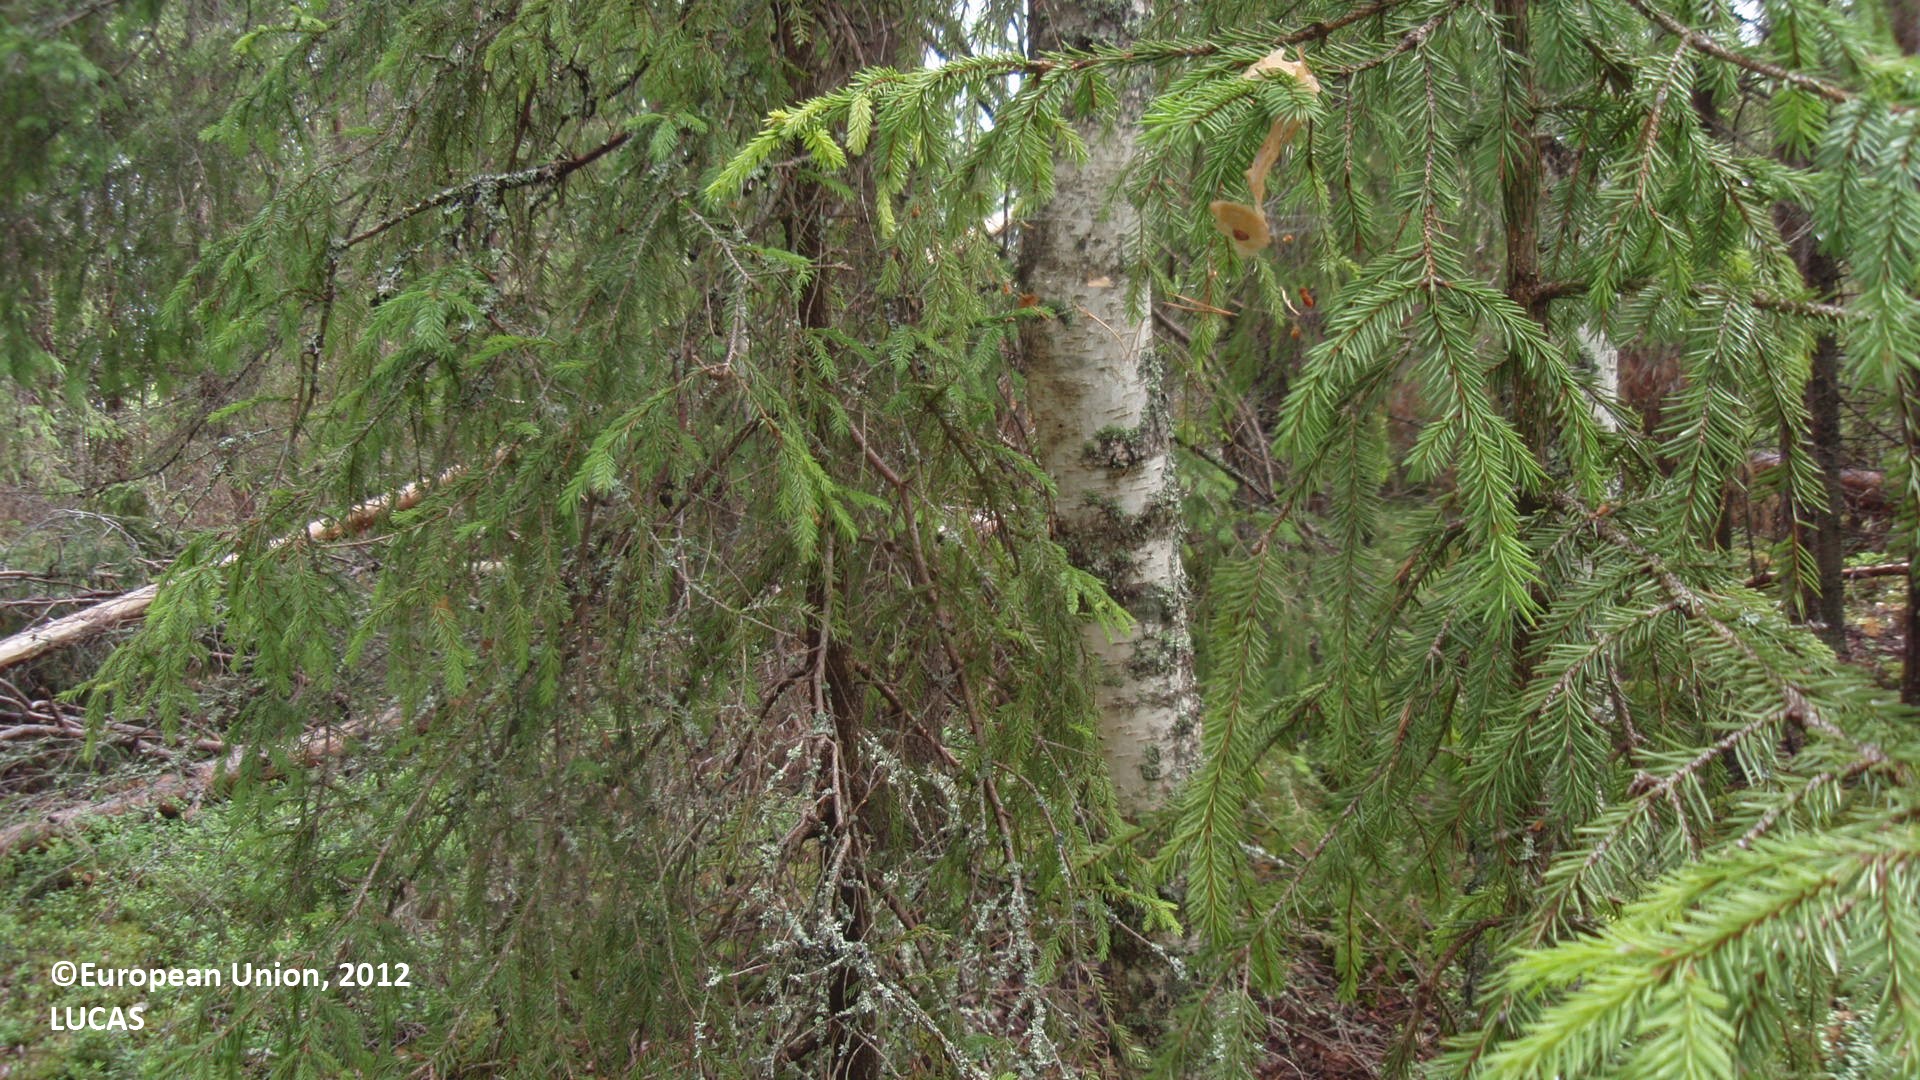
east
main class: Woodland
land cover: Pine dominated mixed woodland
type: boreal forest
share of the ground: 50 - 75 %
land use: Forestry
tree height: > 5 m
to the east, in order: Pine dominated mixed woodland; Spruce dominated mixed woodland; Ditches and canals; Broadleaved woodland; Grassland with sparse tree/shrub cover; Paved roads, cycling and walking lanes; Grassland with sparse tree/shrub cover; Paved roads, cycling and walking lanes; Ditches and canals; Grassland with sparse tree/shrub cover; Broadleaved woodland; Pine dominated coniferous woodland
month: July
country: FI
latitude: 61.6277
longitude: 28.8422
